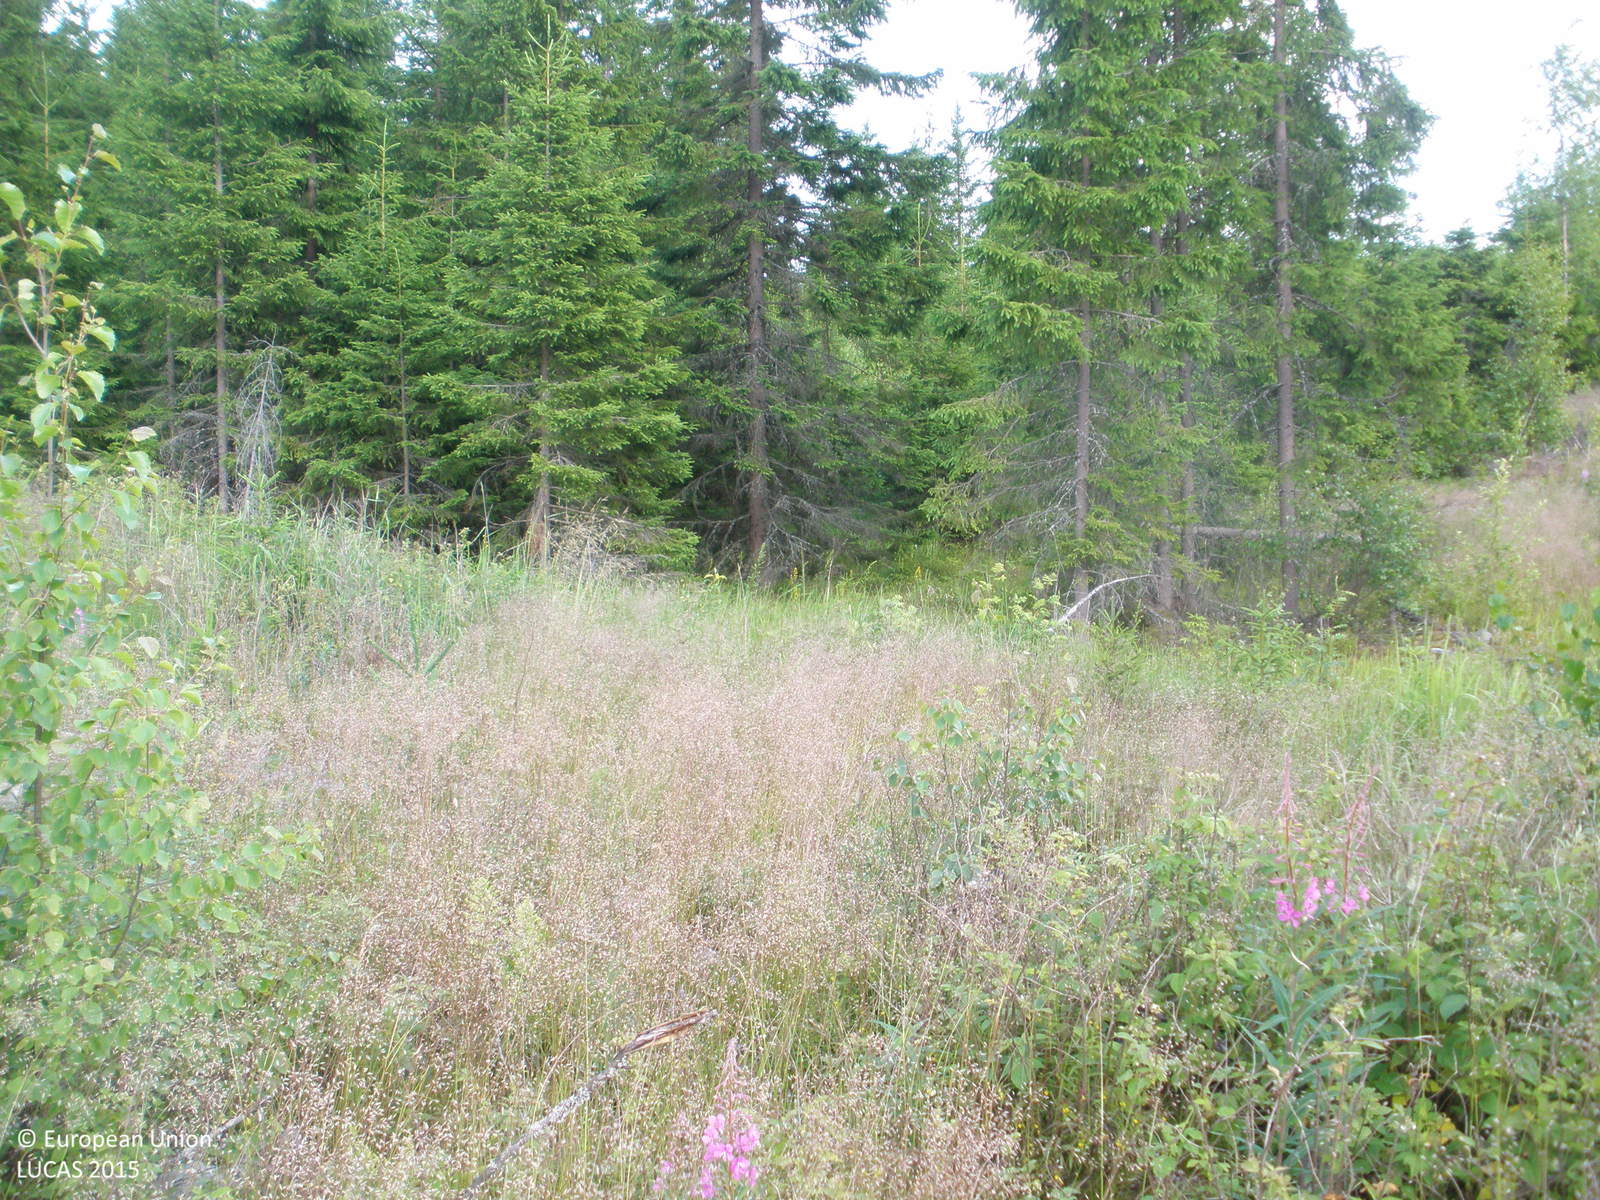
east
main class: Grassland
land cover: Grassland with sparse tree/shrub cover
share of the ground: > 75 %
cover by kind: herbaceous plants 90 %, coniferous forest trees 5 %, shrubs 5 %
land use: Forestry
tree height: < 5 m
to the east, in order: Grassland with sparse tree/shrub cover; Spruce dominated coniferous woodland; Spruce dominated mixed woodland; Spruce dominated coniferous woodland
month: July
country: FI
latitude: 61.3886
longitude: 23.9601
